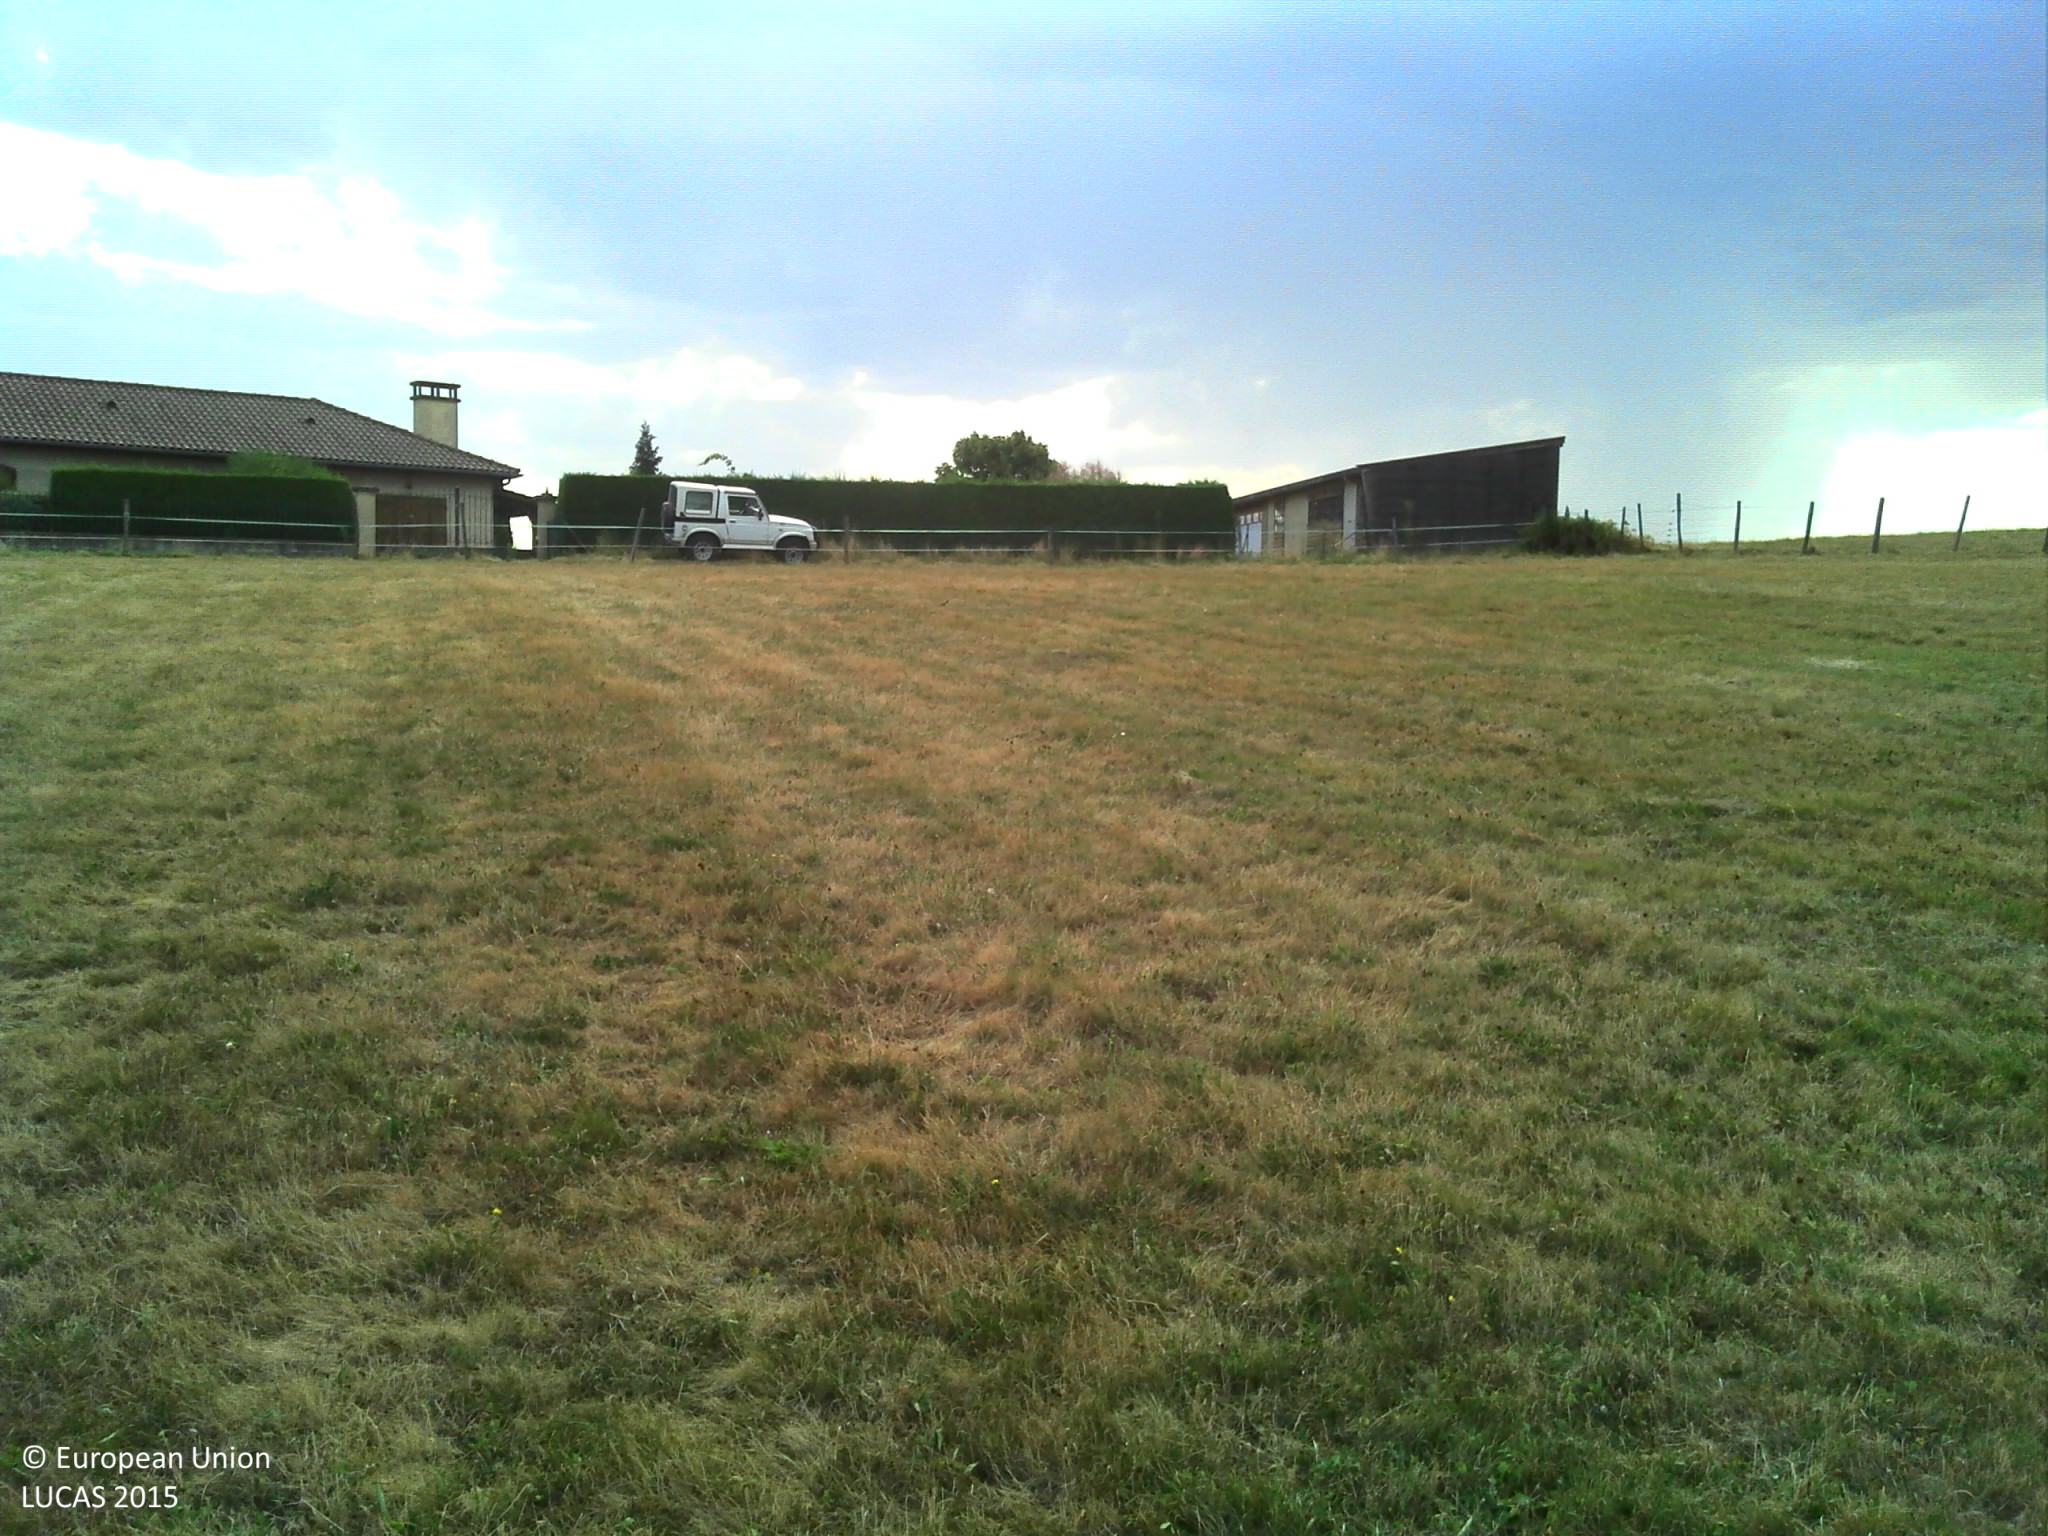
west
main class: Grassland
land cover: Grassland without tree/shrub cover
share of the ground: > 75 %
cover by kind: herbaceous plants 100 %
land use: Agriculture (excluding fallow land and kitchen gardens)
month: August
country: FR
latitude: 45.4869
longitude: 4.4893
